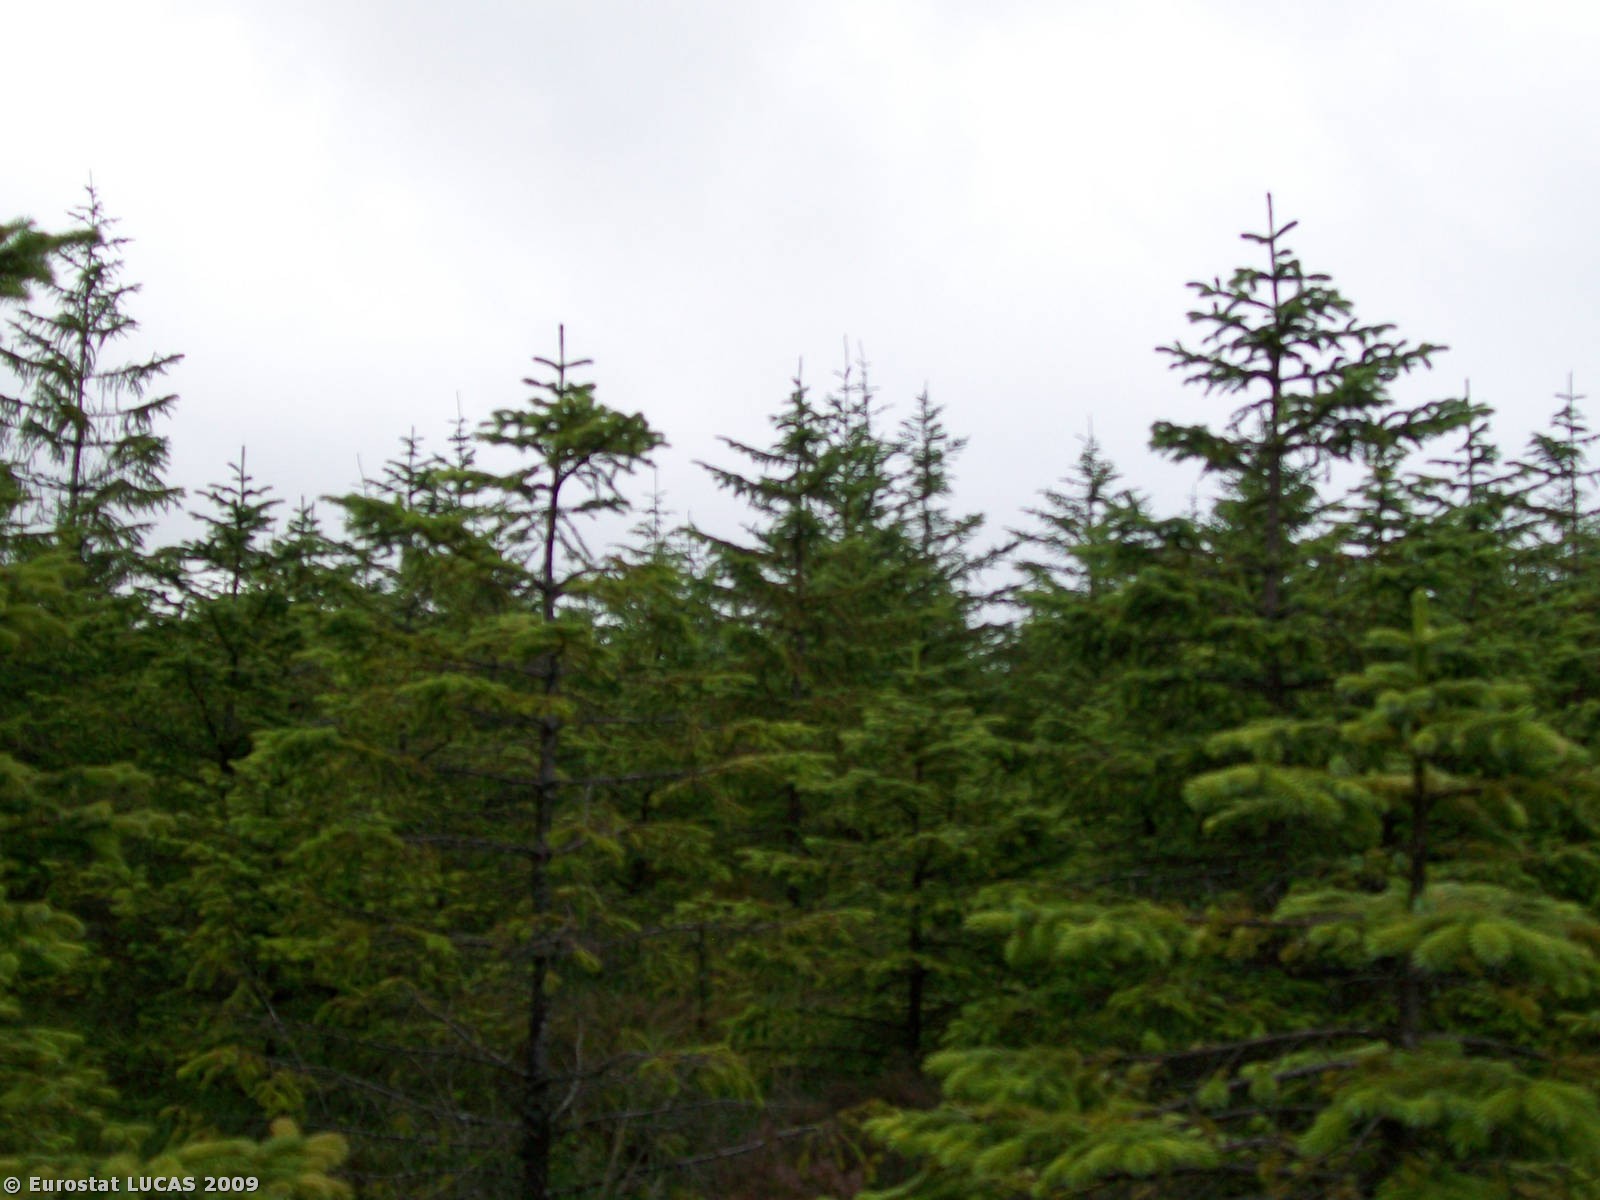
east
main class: Woodland
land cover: Coniferous woodland
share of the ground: > 75 %
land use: Forestry
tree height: < 5 m
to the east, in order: Coniferous woodland; Tracks; Coniferous woodland; Other structural elements; Coniferous woodland
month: August
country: IE
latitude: 53.3855
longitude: -9.3980
